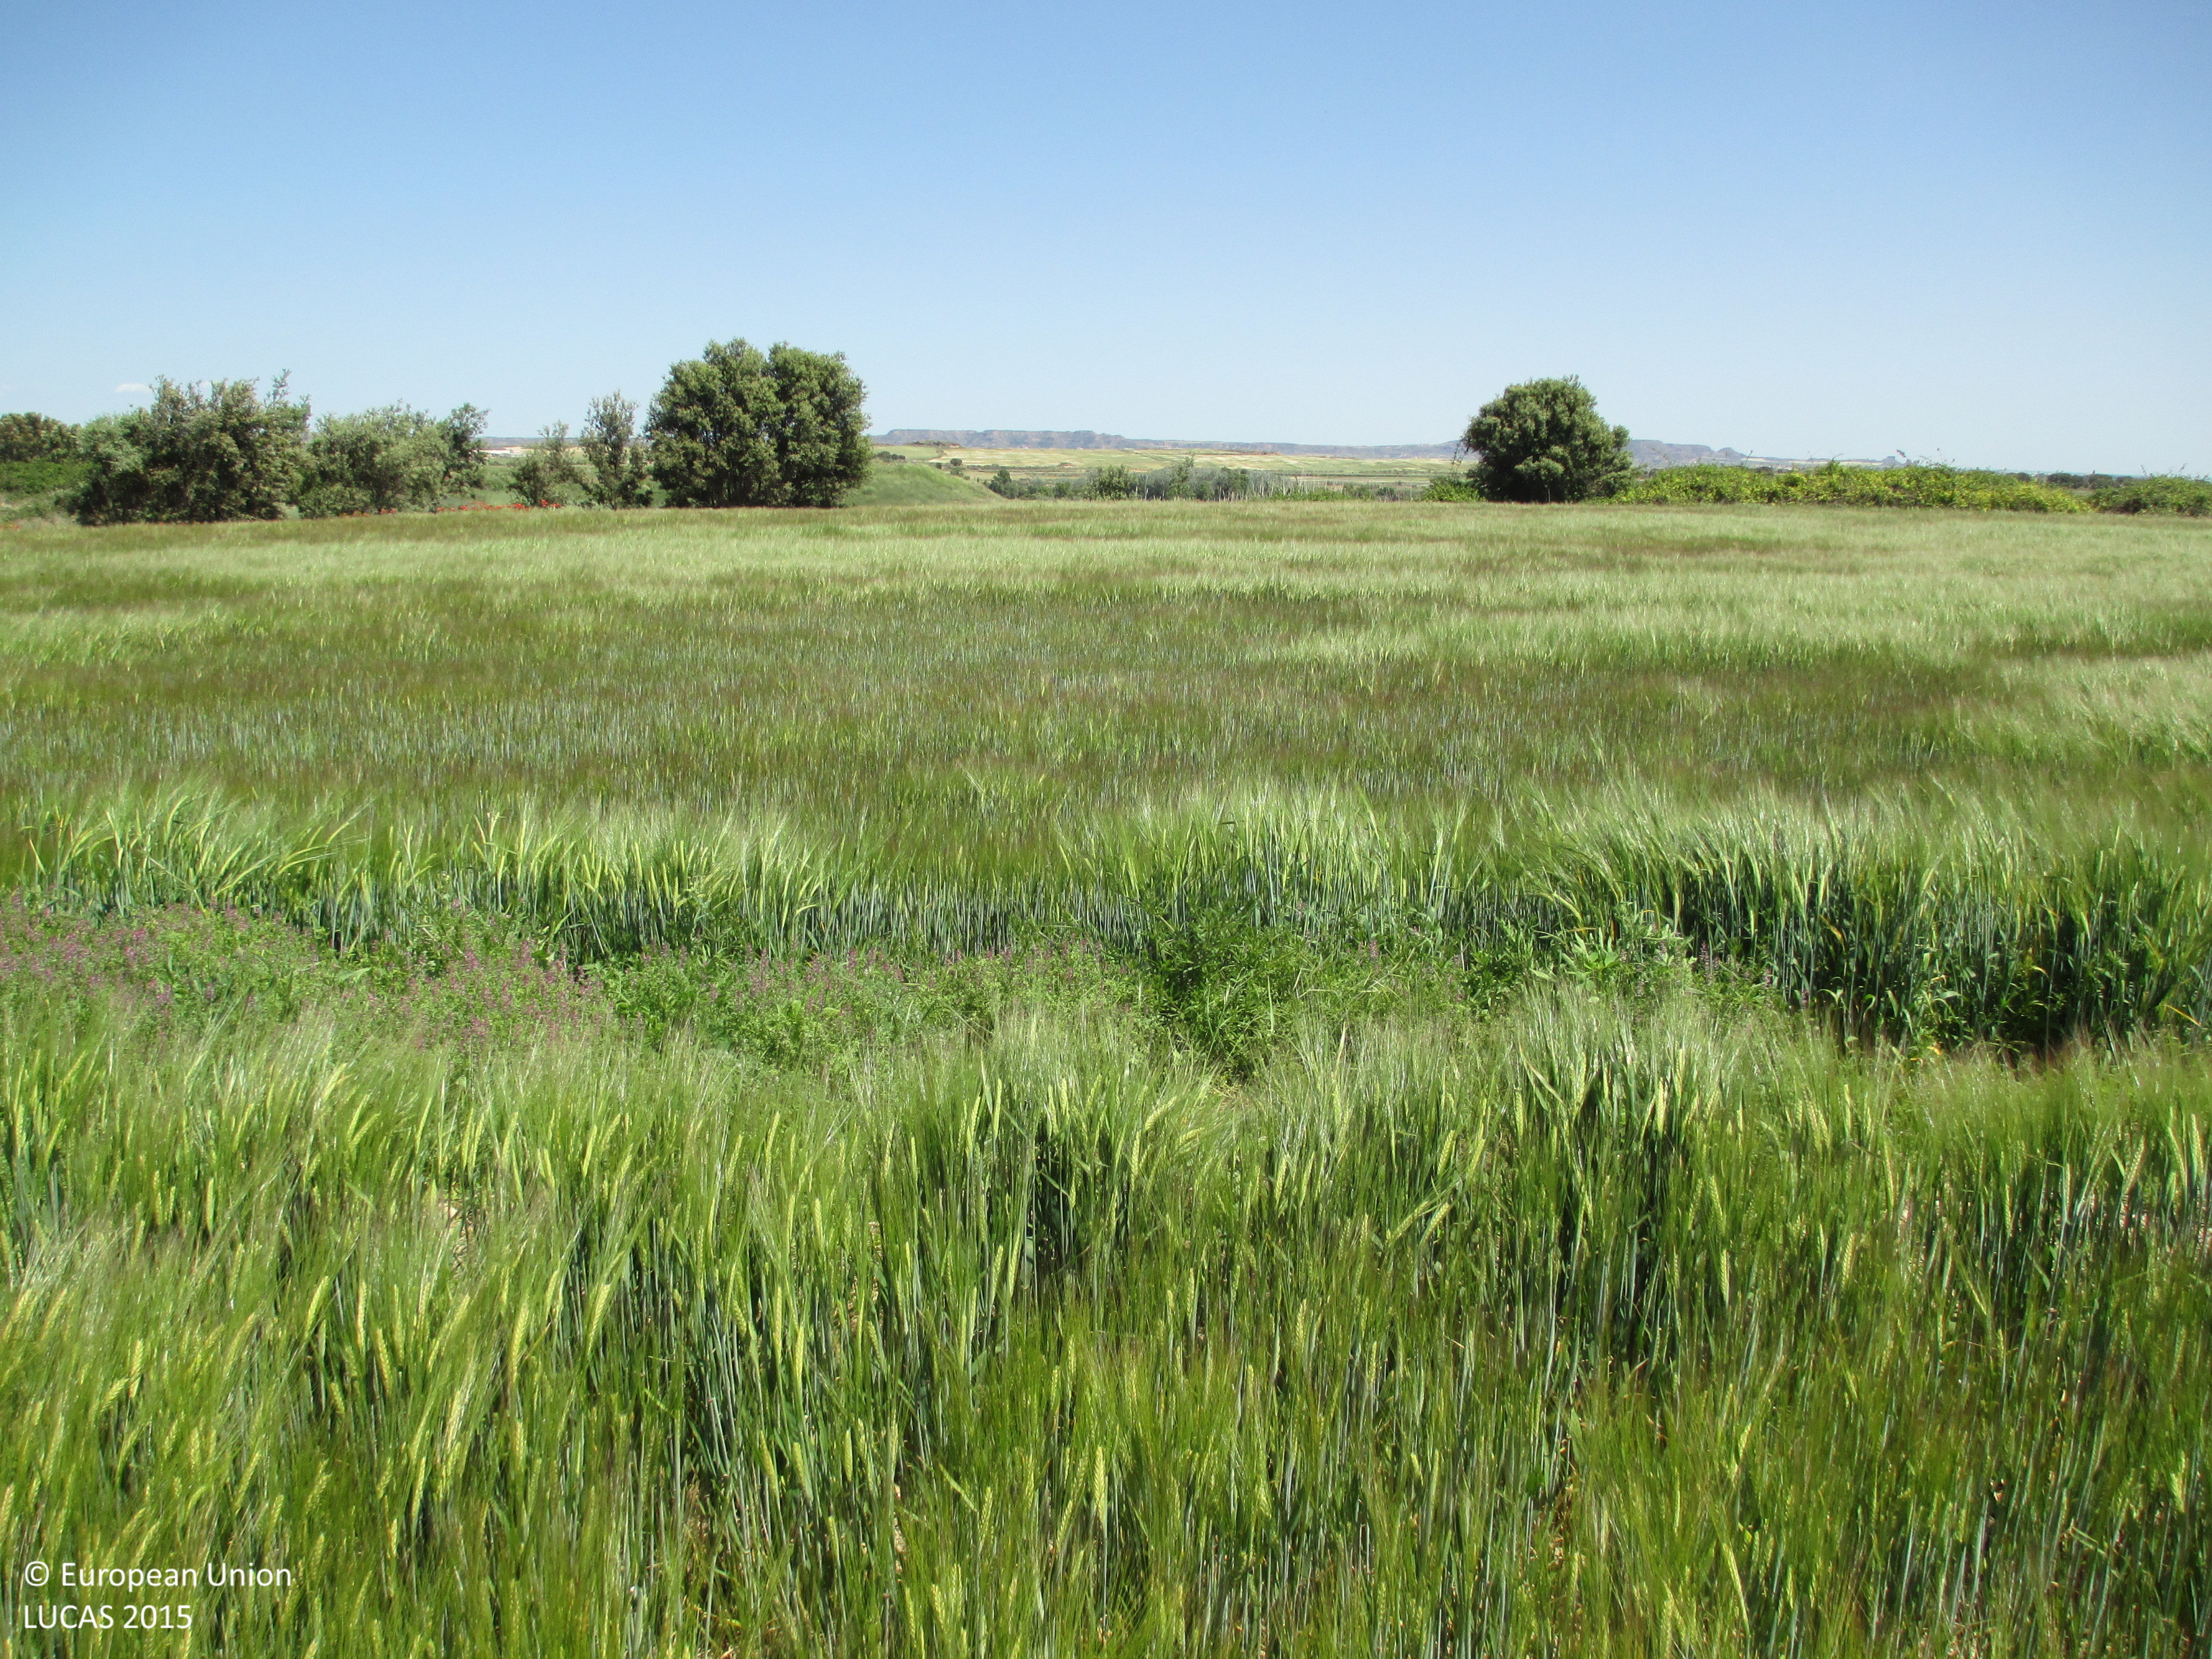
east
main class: Cropland
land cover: Barley
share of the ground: > 75 %
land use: Agriculture (excluding fallow land and kitchen gardens)
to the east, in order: Barley; Grass margins; Barley; Grassland with sparse tree/shrub cover; Inland marshes
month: May
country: ES
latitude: 41.9680
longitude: -0.4349
